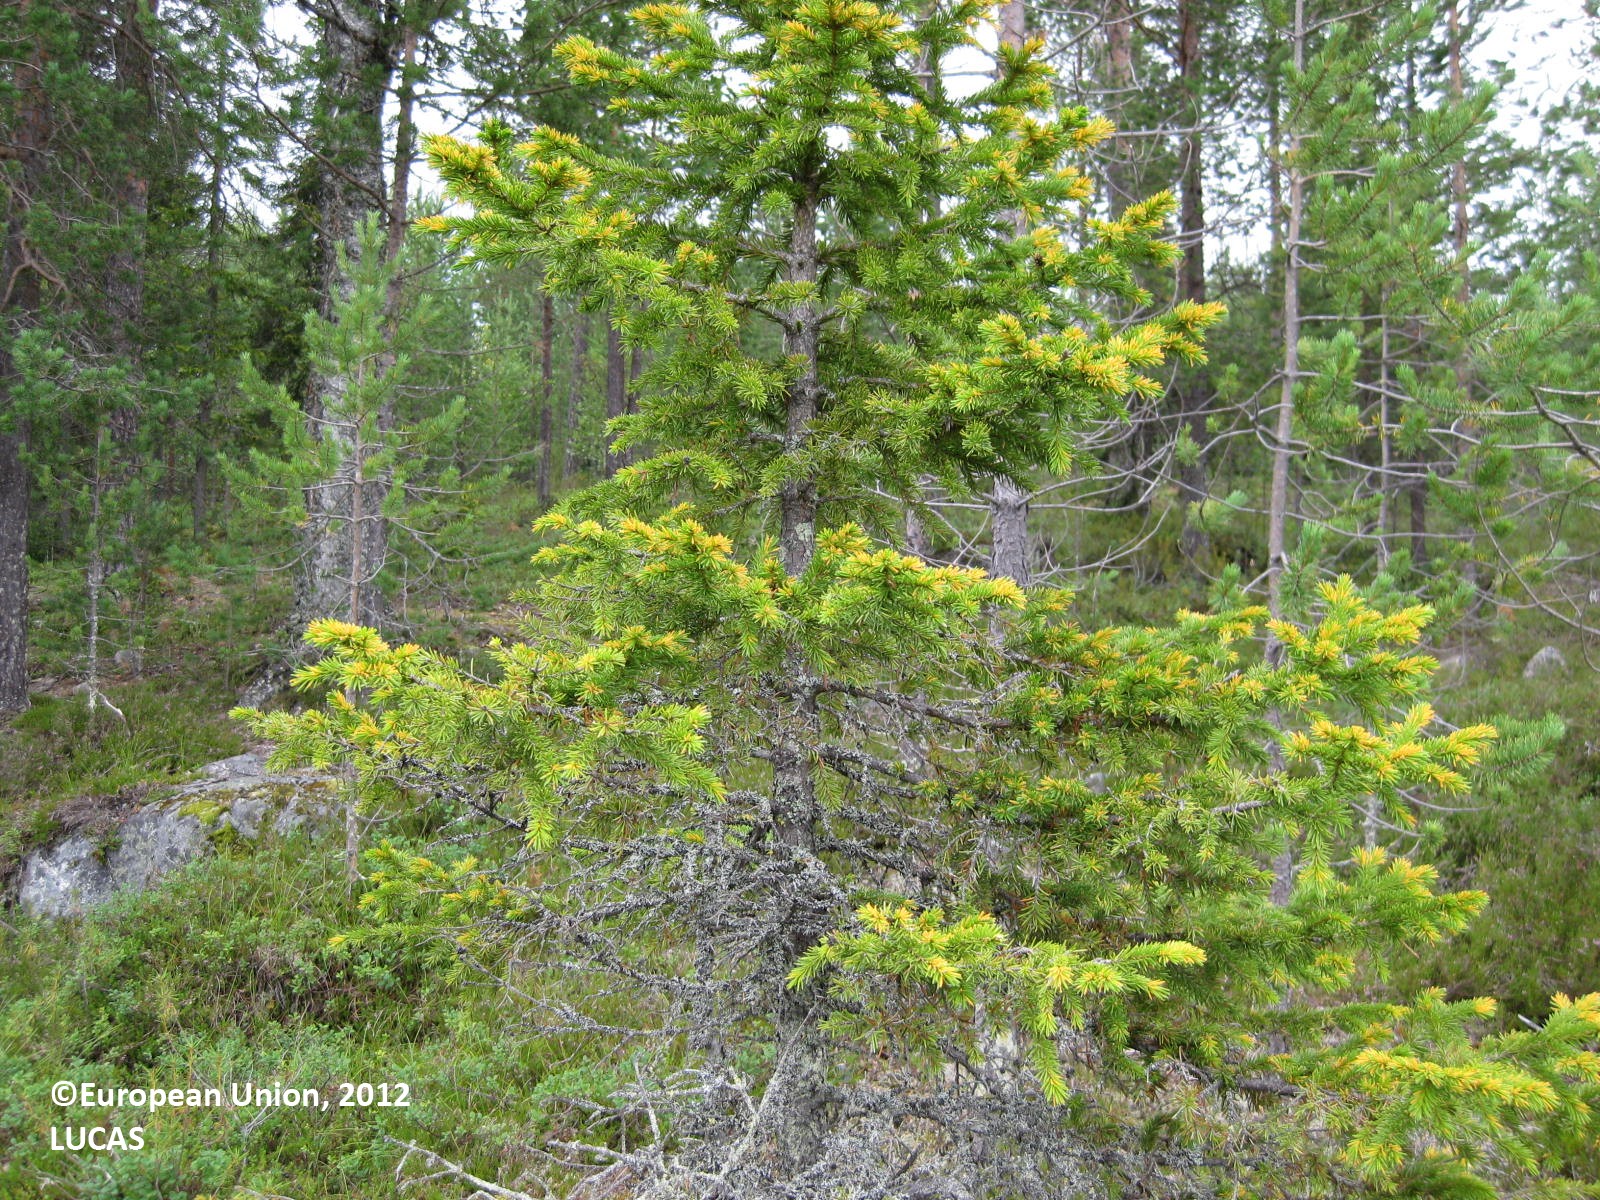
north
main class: Woodland
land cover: Pine dominated coniferous woodland
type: boreal forest
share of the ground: > 75 %
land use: Forestry
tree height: > 5 m
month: July
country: FI
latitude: 65.9254
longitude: 28.5448
